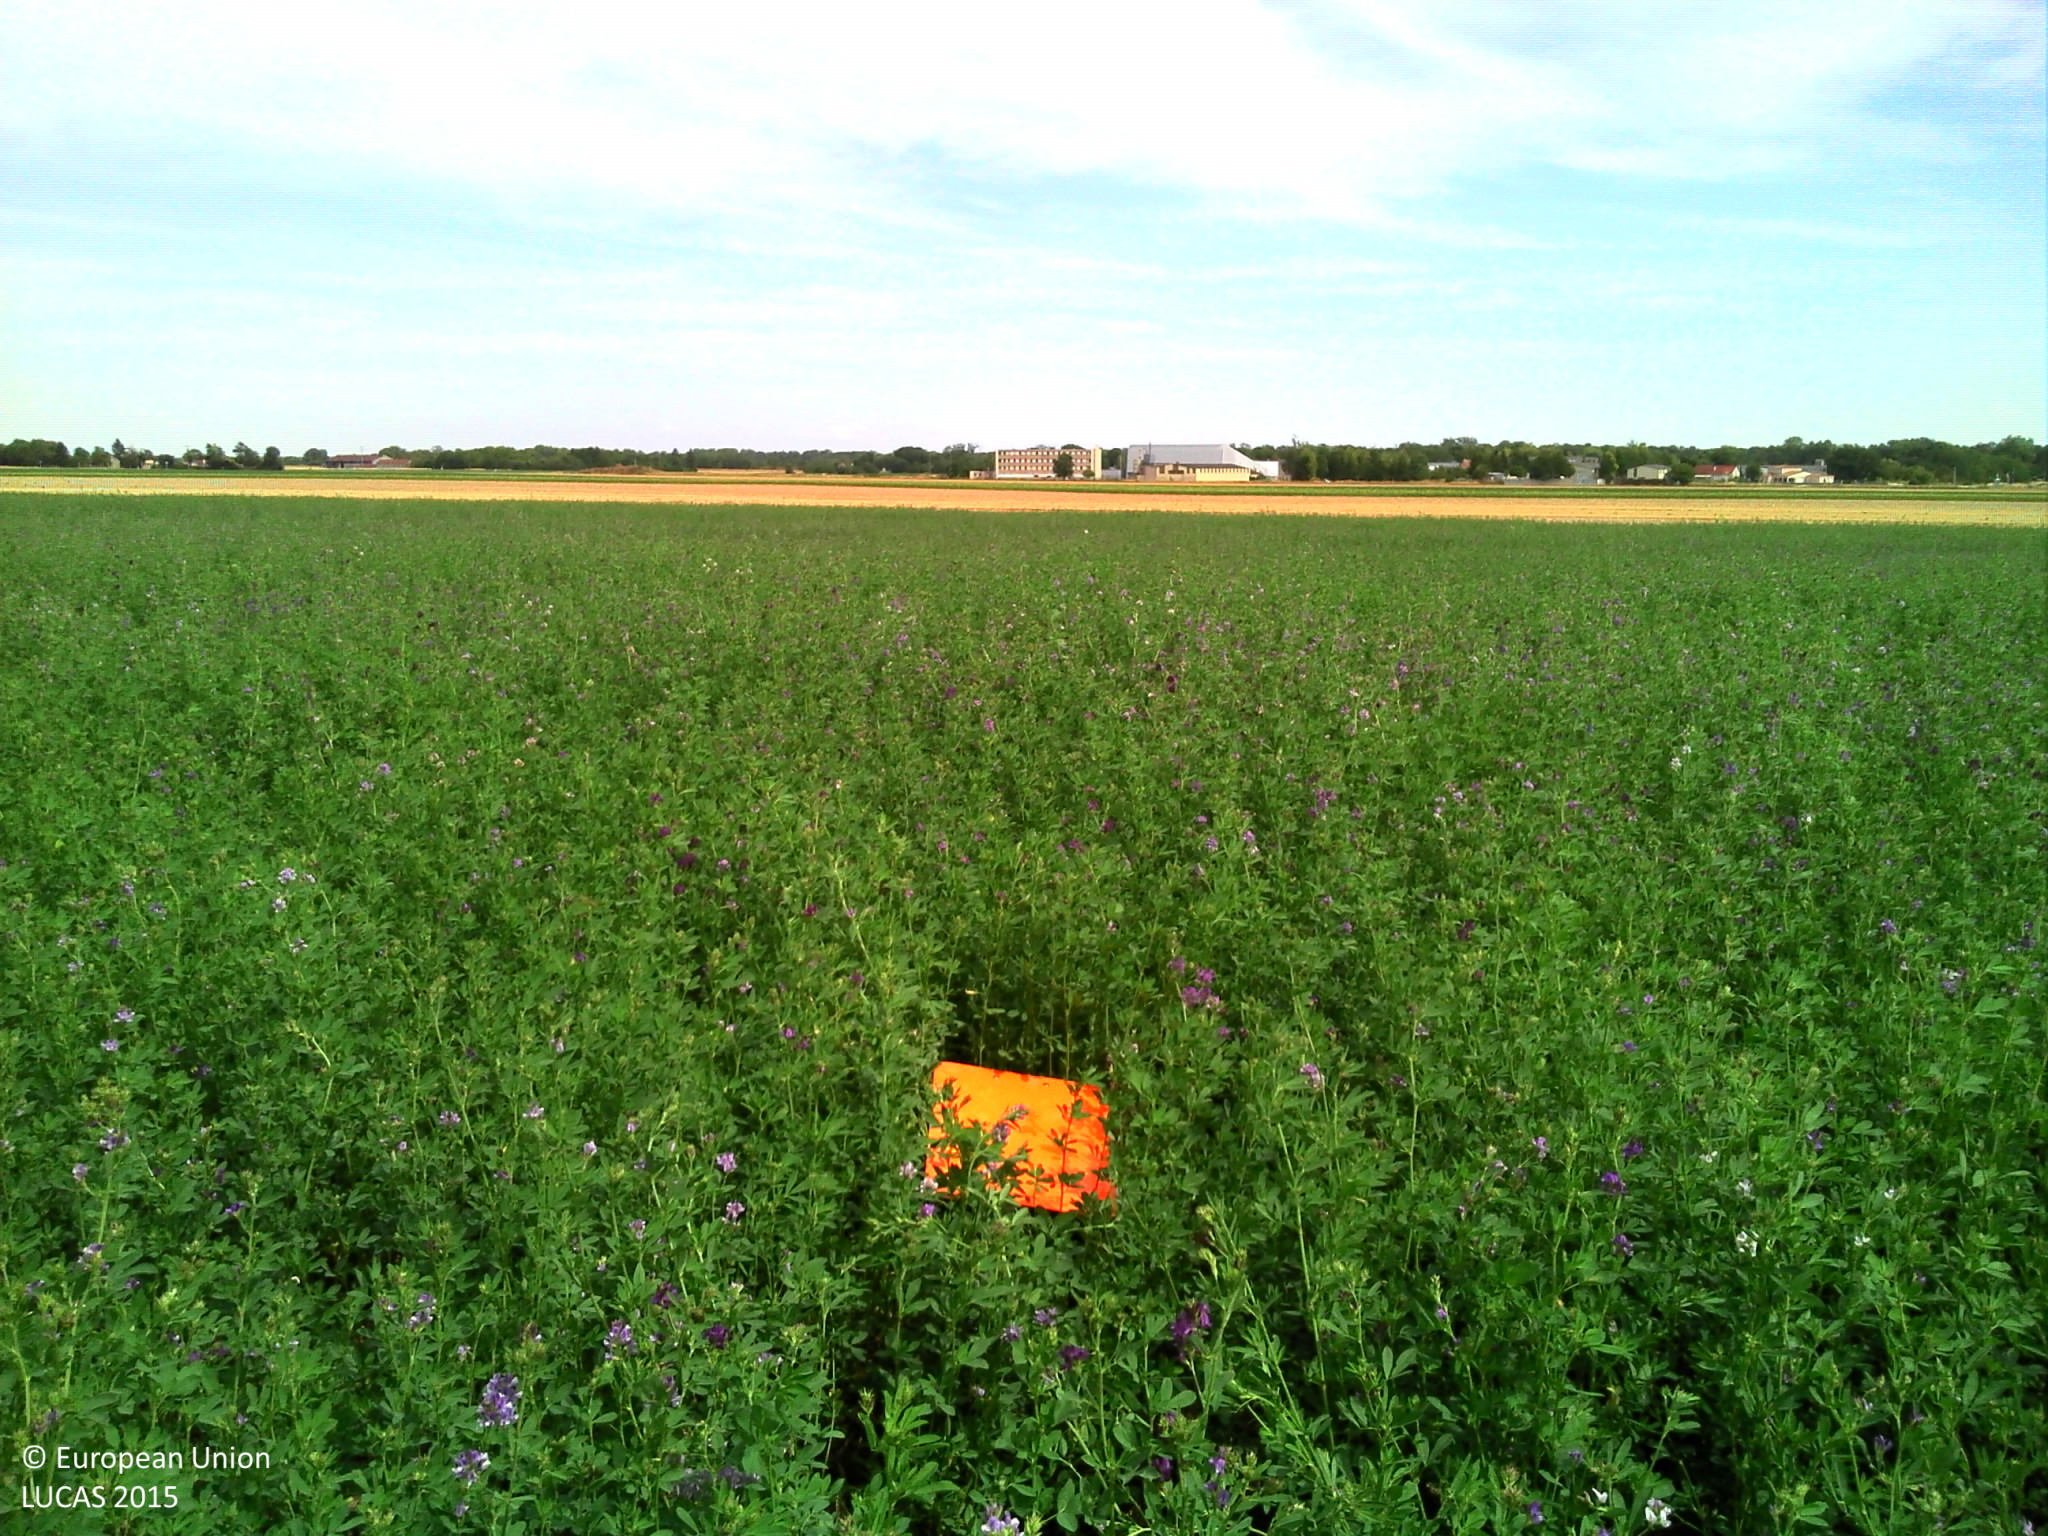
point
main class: Cropland
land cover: Lucerne
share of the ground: > 75 %
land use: Agriculture (excluding fallow land and kitchen gardens)
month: August
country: FR
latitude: 49.1406
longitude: 4.3073
